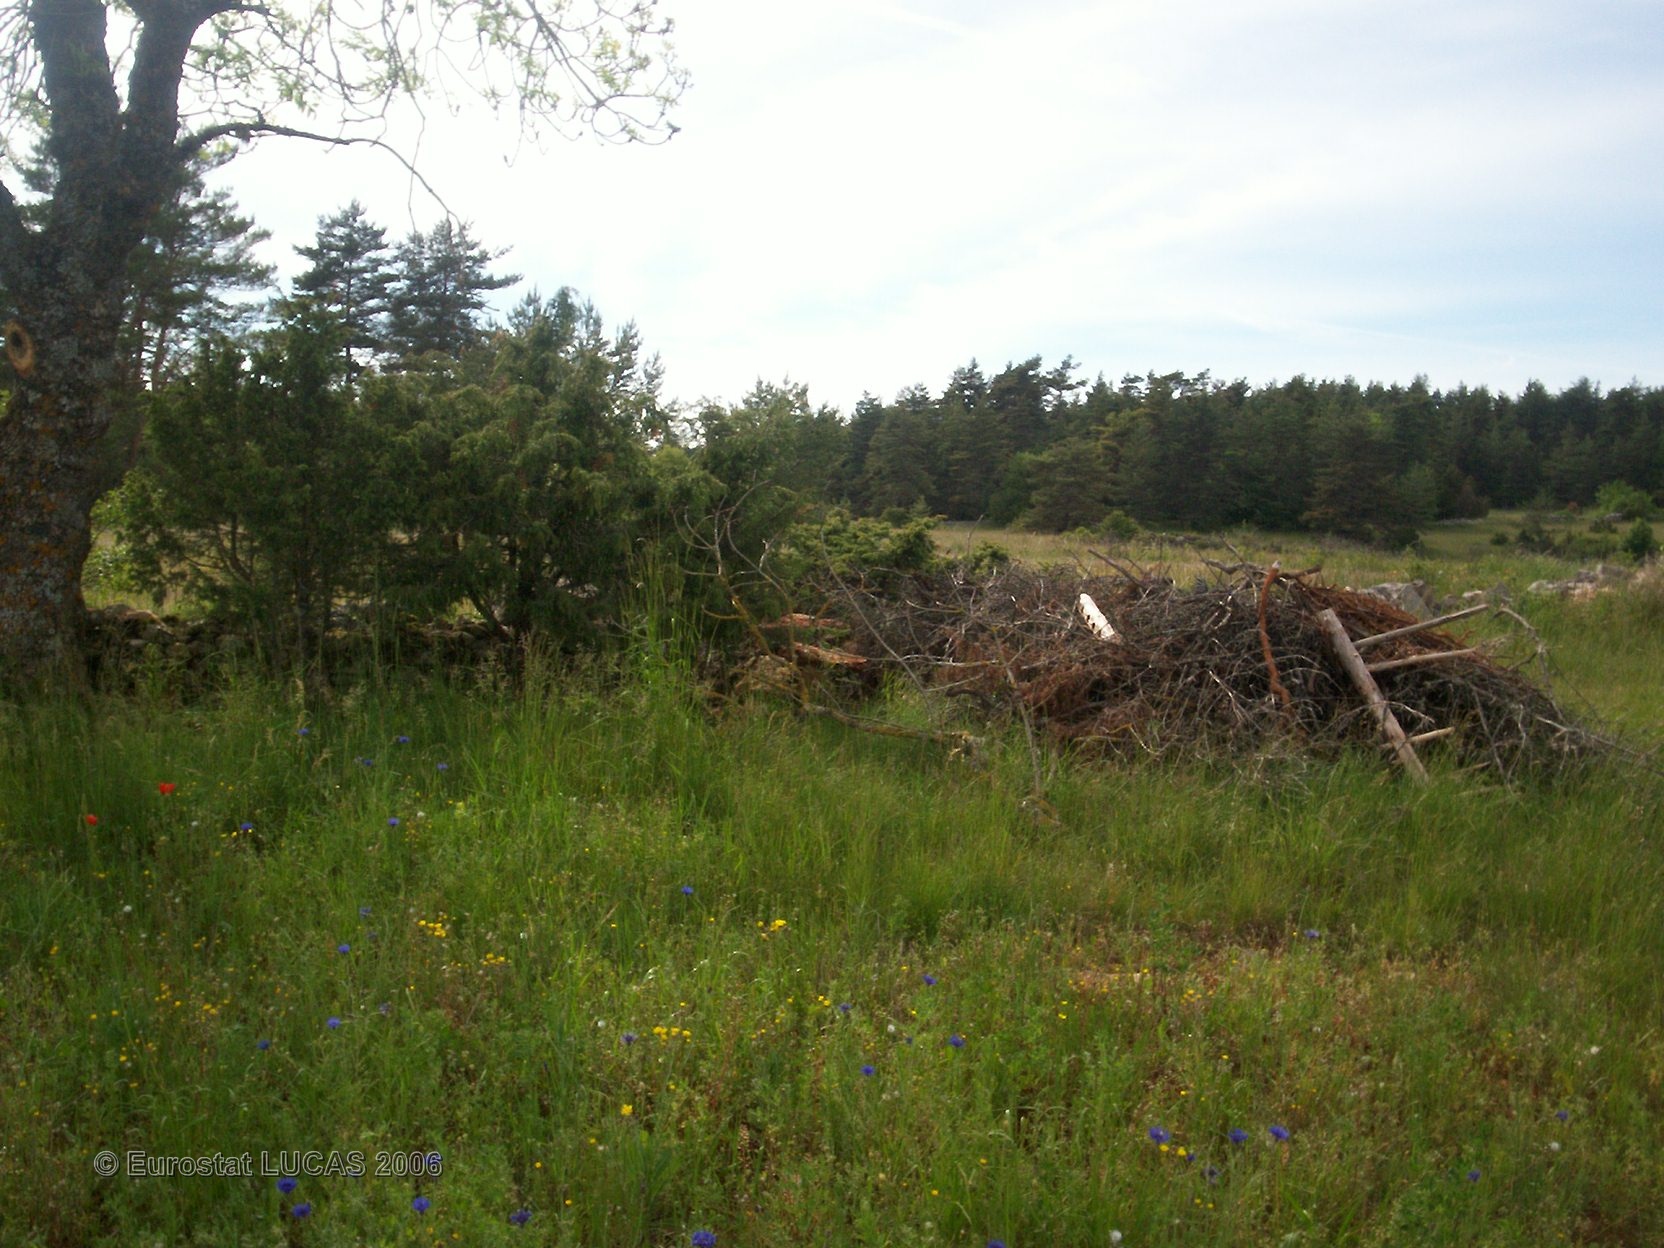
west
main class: Grassland
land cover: Grassland without tree/shrub cover
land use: Agriculture (excluding fallow land and kitchen gardens)
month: June
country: FR
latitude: 44.4680
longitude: 3.4311
